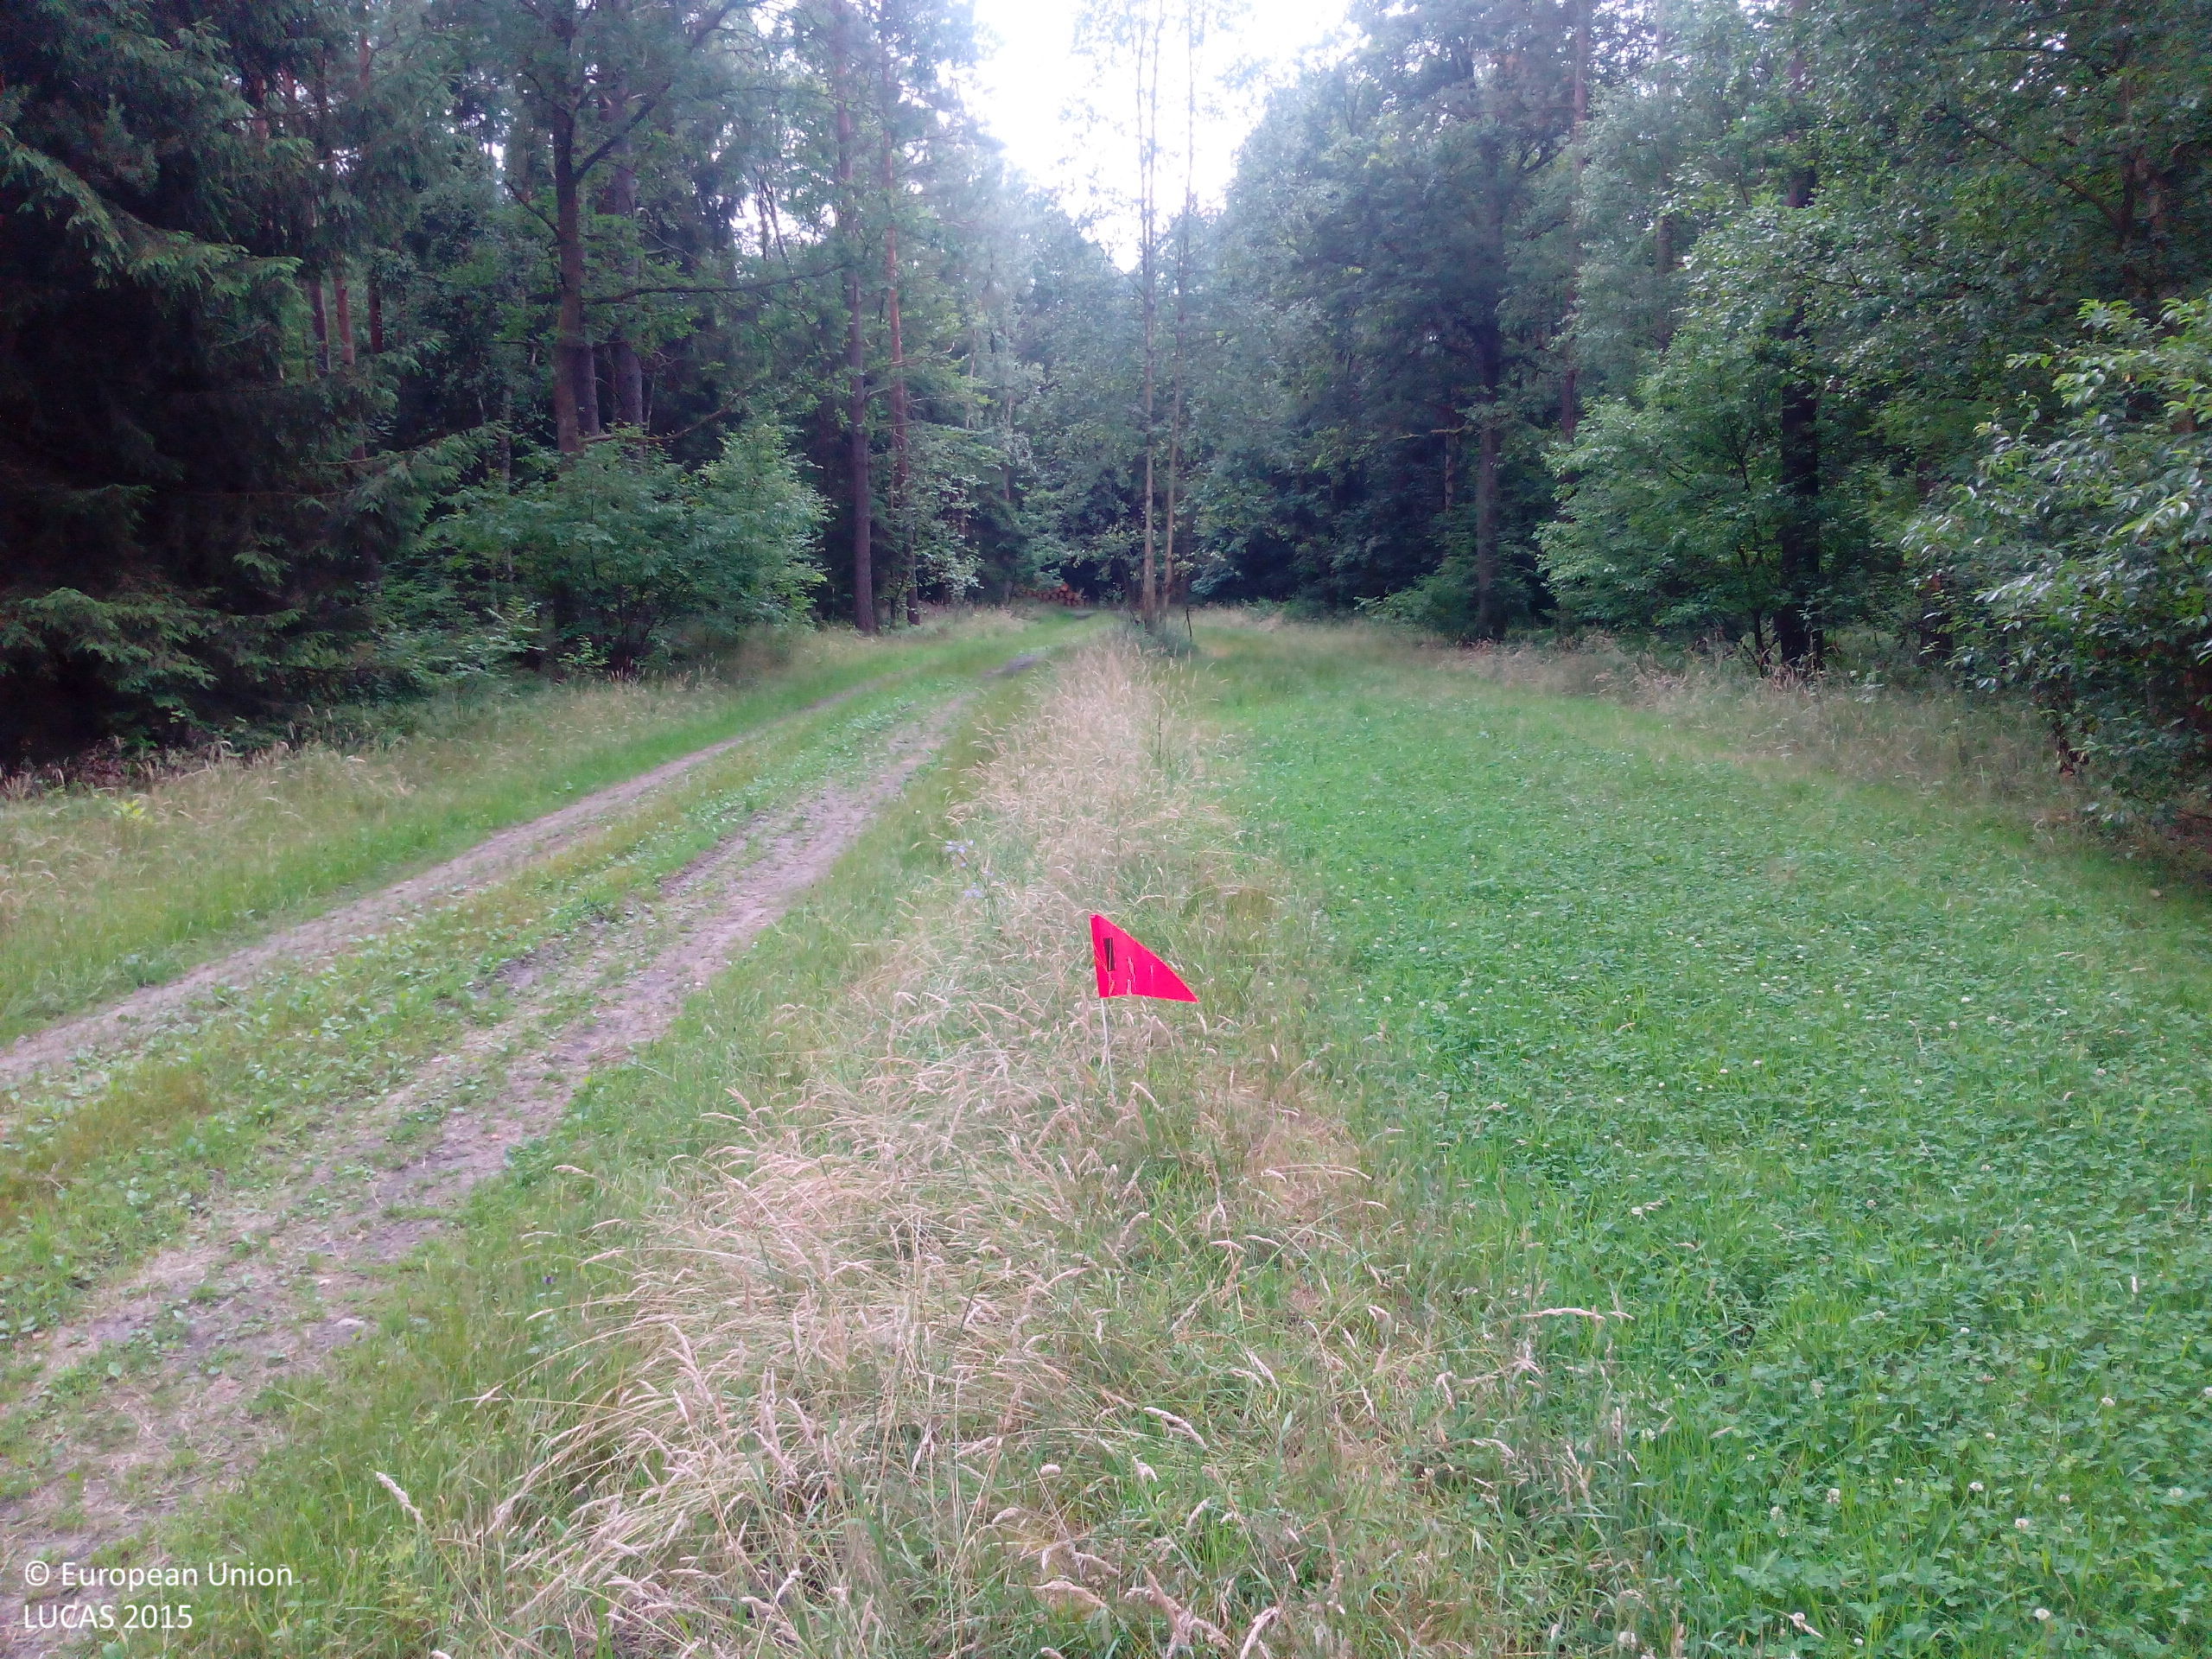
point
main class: Grassland
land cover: Grassland without tree/shrub cover
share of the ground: > 75 %
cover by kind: herbaceous plants 90 %, unconsolidated bare surface 10 %
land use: Road transport
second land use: Forestry
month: July
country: DE
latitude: 52.8444
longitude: 10.3117
